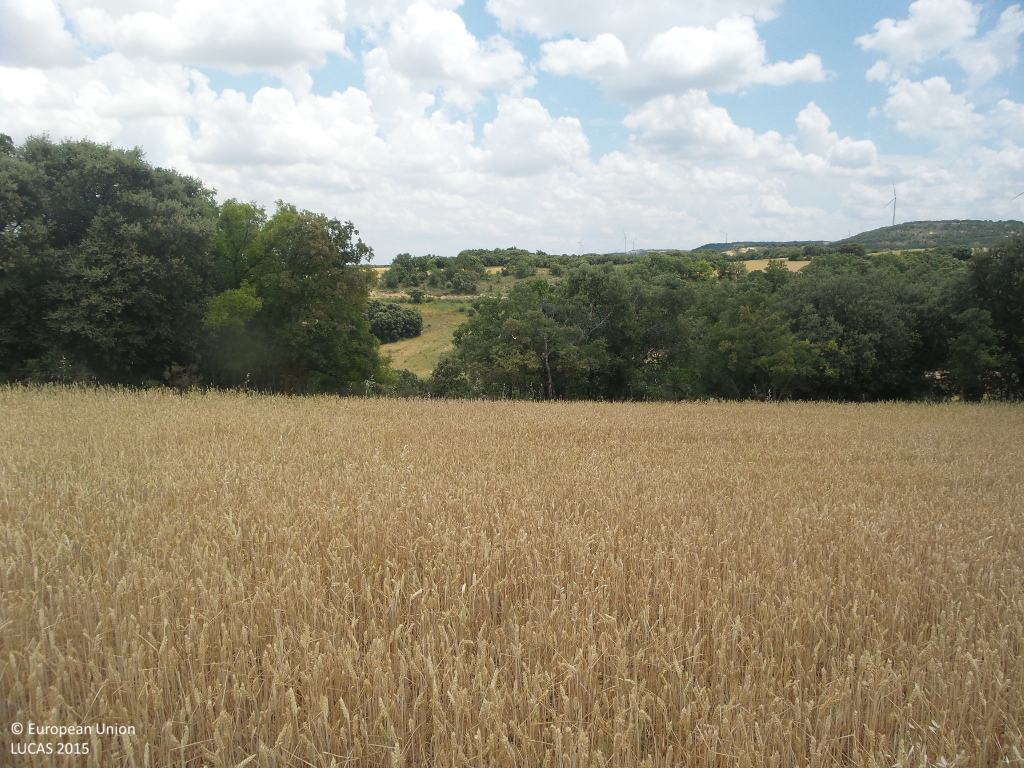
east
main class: Cropland
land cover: Common wheat
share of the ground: > 75 %
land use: Agriculture (excluding fallow land and kitchen gardens)
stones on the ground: < 10 %
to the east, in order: Common wheat; Broadleaved woodland; Shrubland without tree cover; Tracks; Spontaneously vegetated surfaces; Grassland with sparse tree/shrub cover; Broadleaved woodland
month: June
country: ES
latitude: 41.4445
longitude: -2.7370
